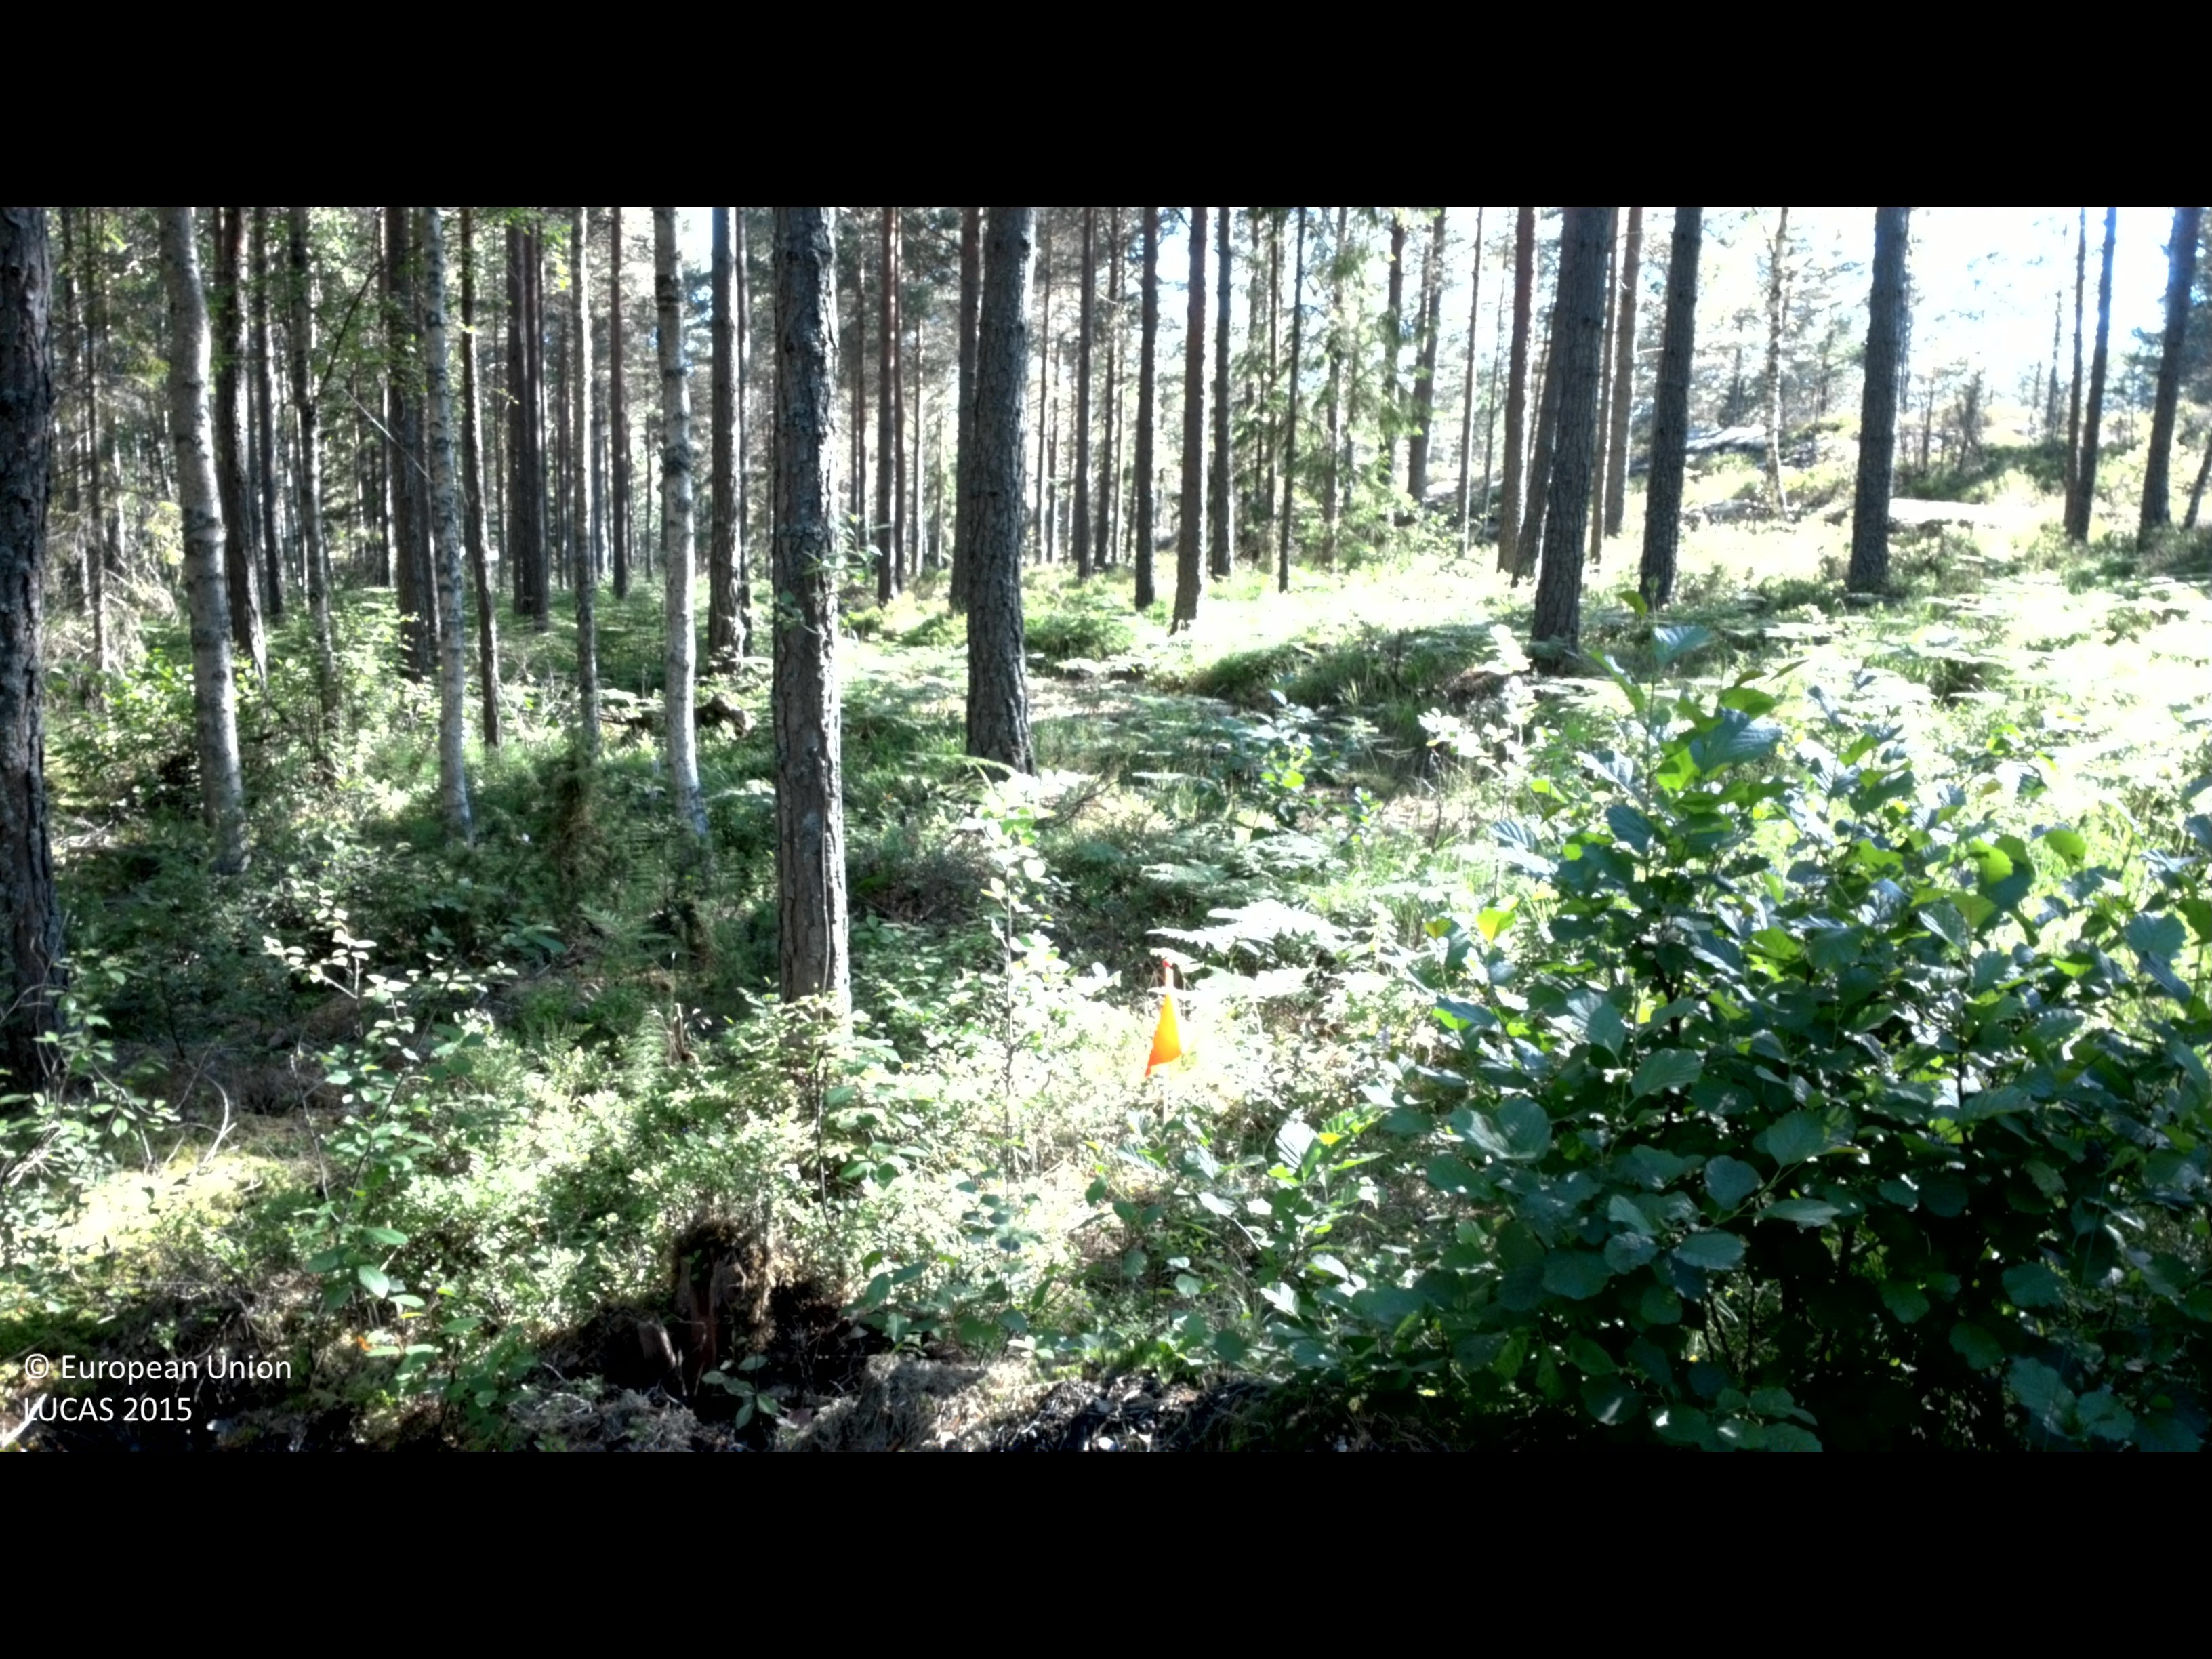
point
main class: Woodland
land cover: Pine dominated mixed woodland
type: boreal forest
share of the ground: 50 - 75 %
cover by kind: coniferous forest trees 50 %, shrubs 25 %, broadleaved forest trees 20 %, herbaceous plants 5 %
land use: Forestry
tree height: > 5 m
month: July
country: SE
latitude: 58.2351
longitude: 16.6566
